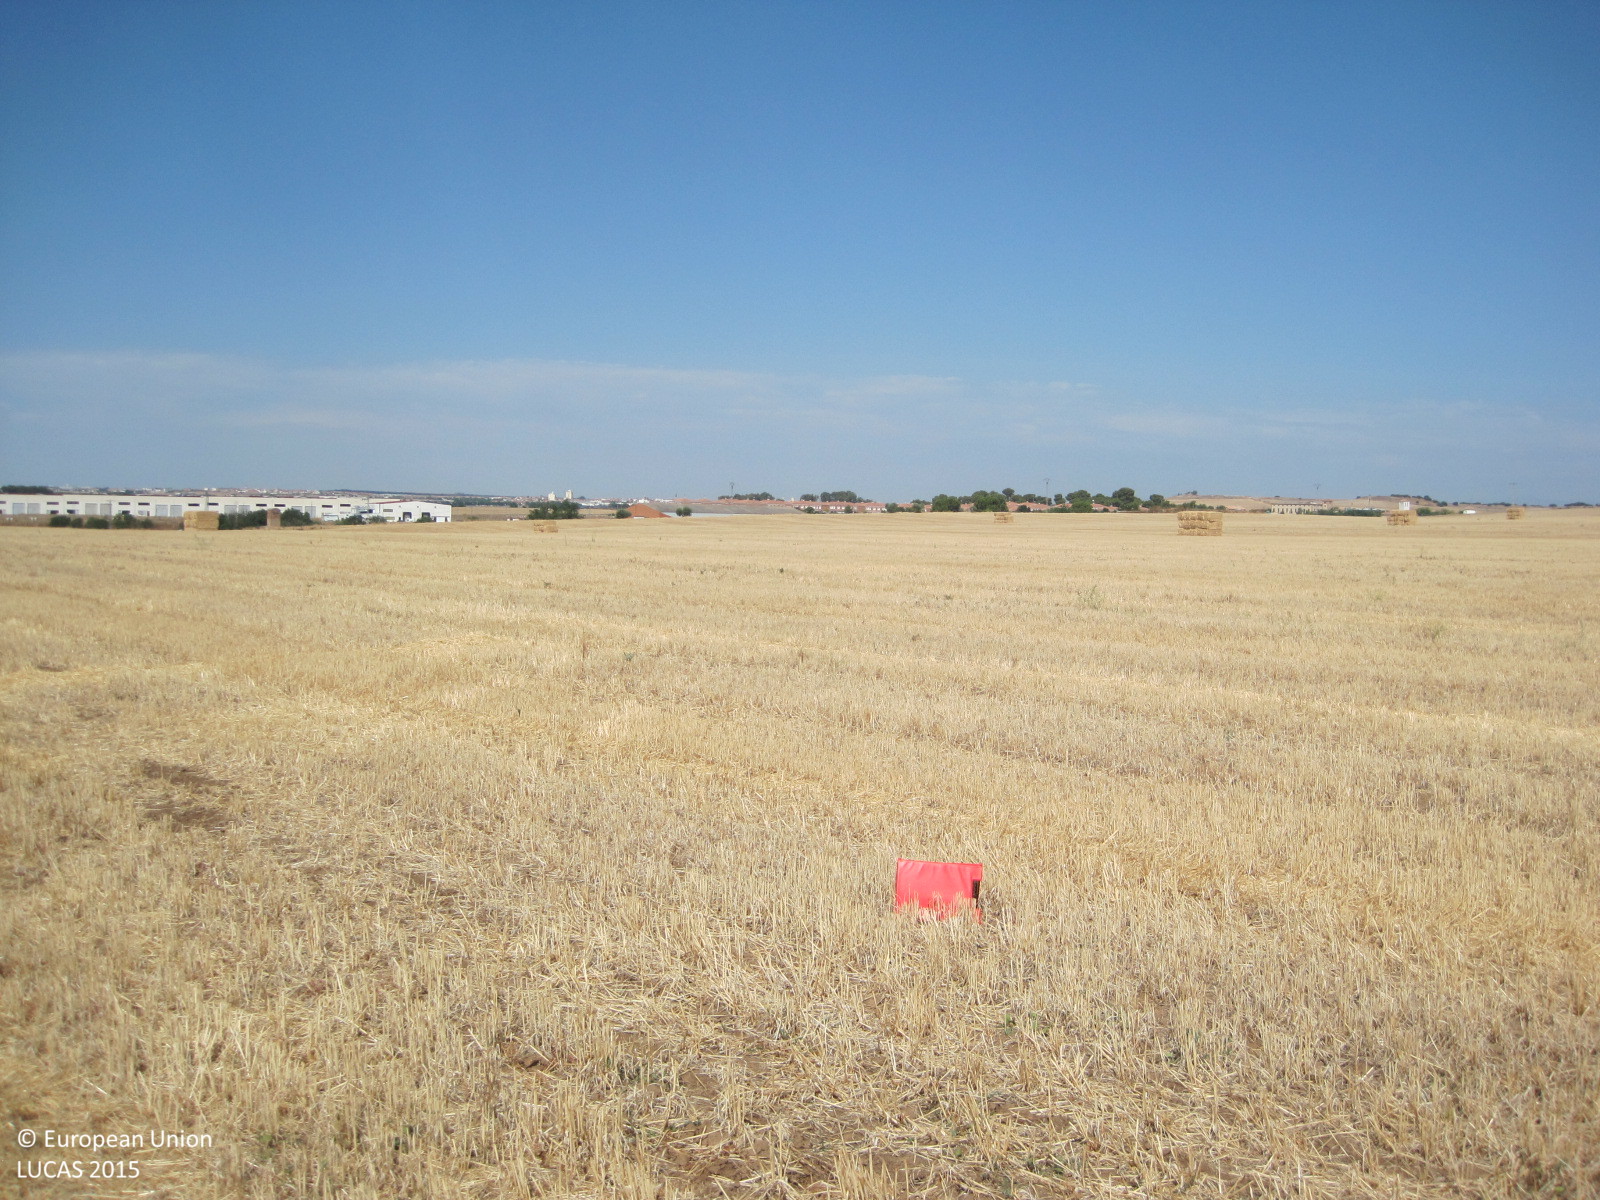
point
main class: Cropland
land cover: Barley
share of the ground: < 10 %
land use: Agriculture (excluding fallow land and kitchen gardens)
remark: Harvested field
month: July
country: ES
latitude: 39.9777
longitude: -4.2189
